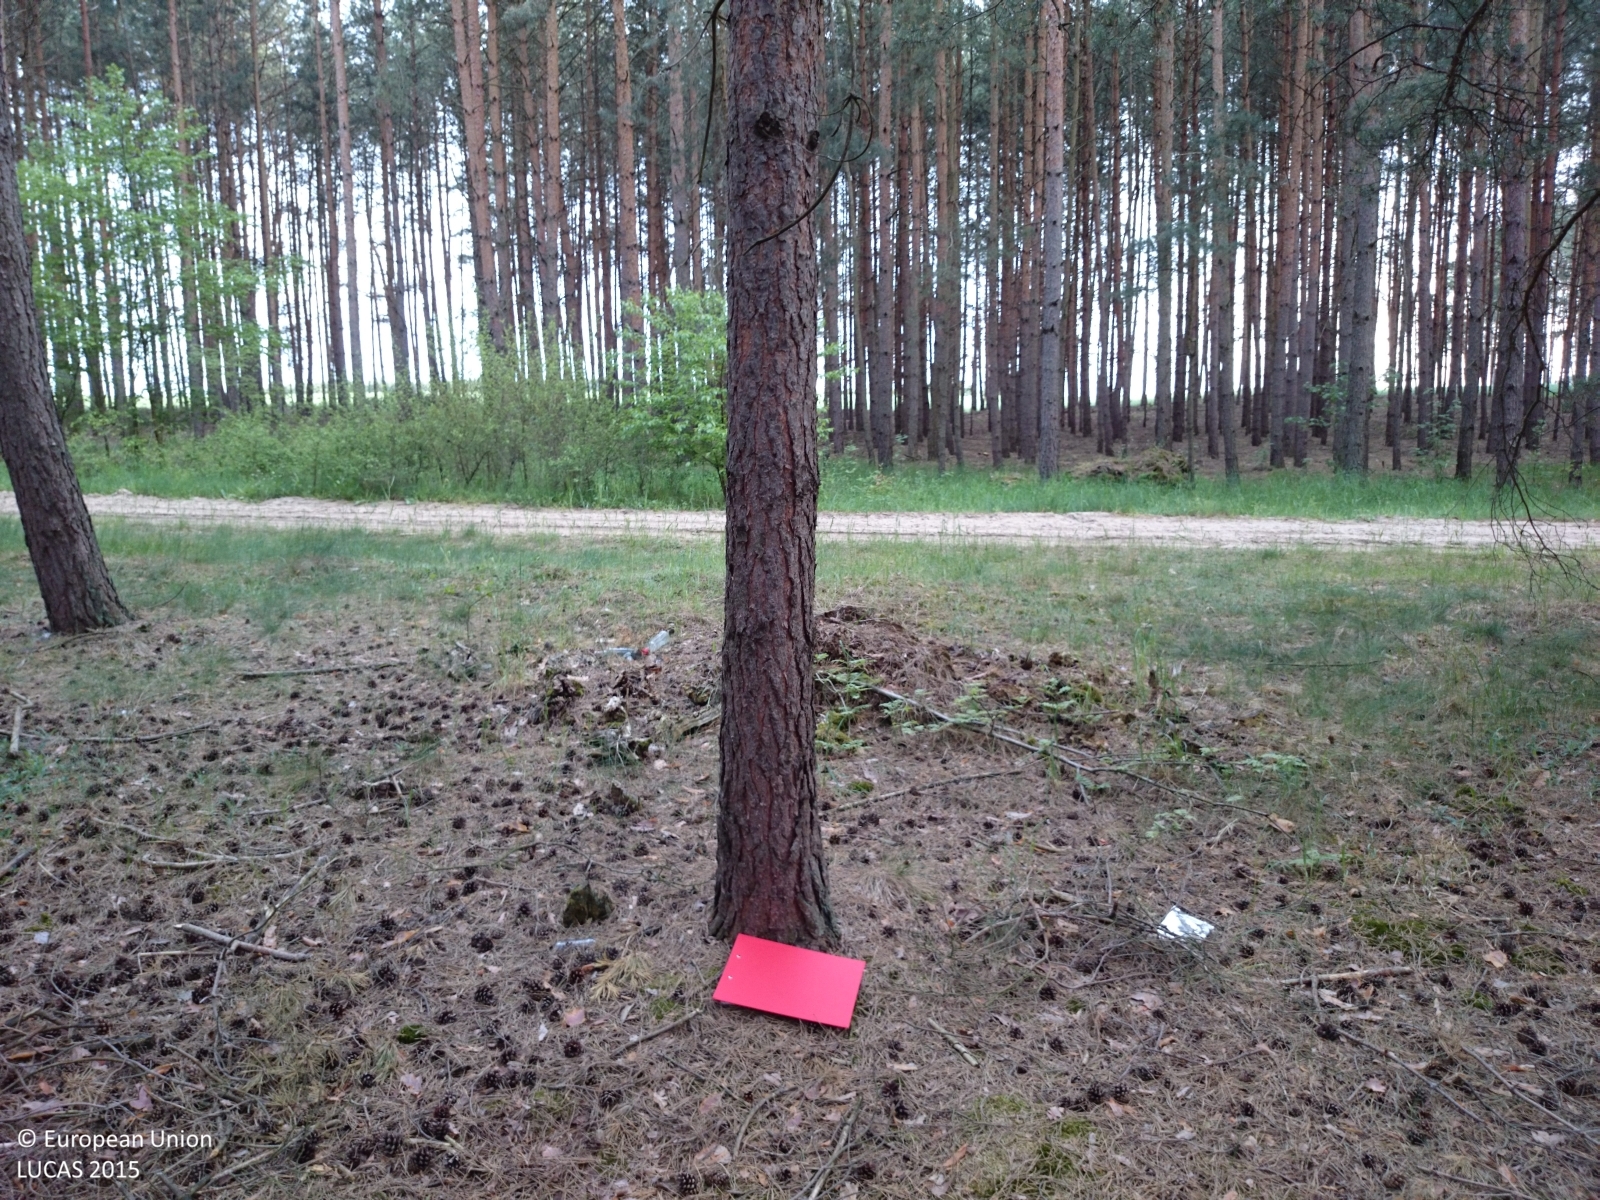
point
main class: Woodland
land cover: Pine dominated coniferous woodland
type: hemiboreal forest and nemoral coniferous forest and mixed broadleaved-coniferous forest
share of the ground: > 75 %
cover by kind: coniferous forest trees 100 %
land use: Forestry
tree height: > 5 m
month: May
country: PL
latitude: 52.6093
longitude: 16.2531
